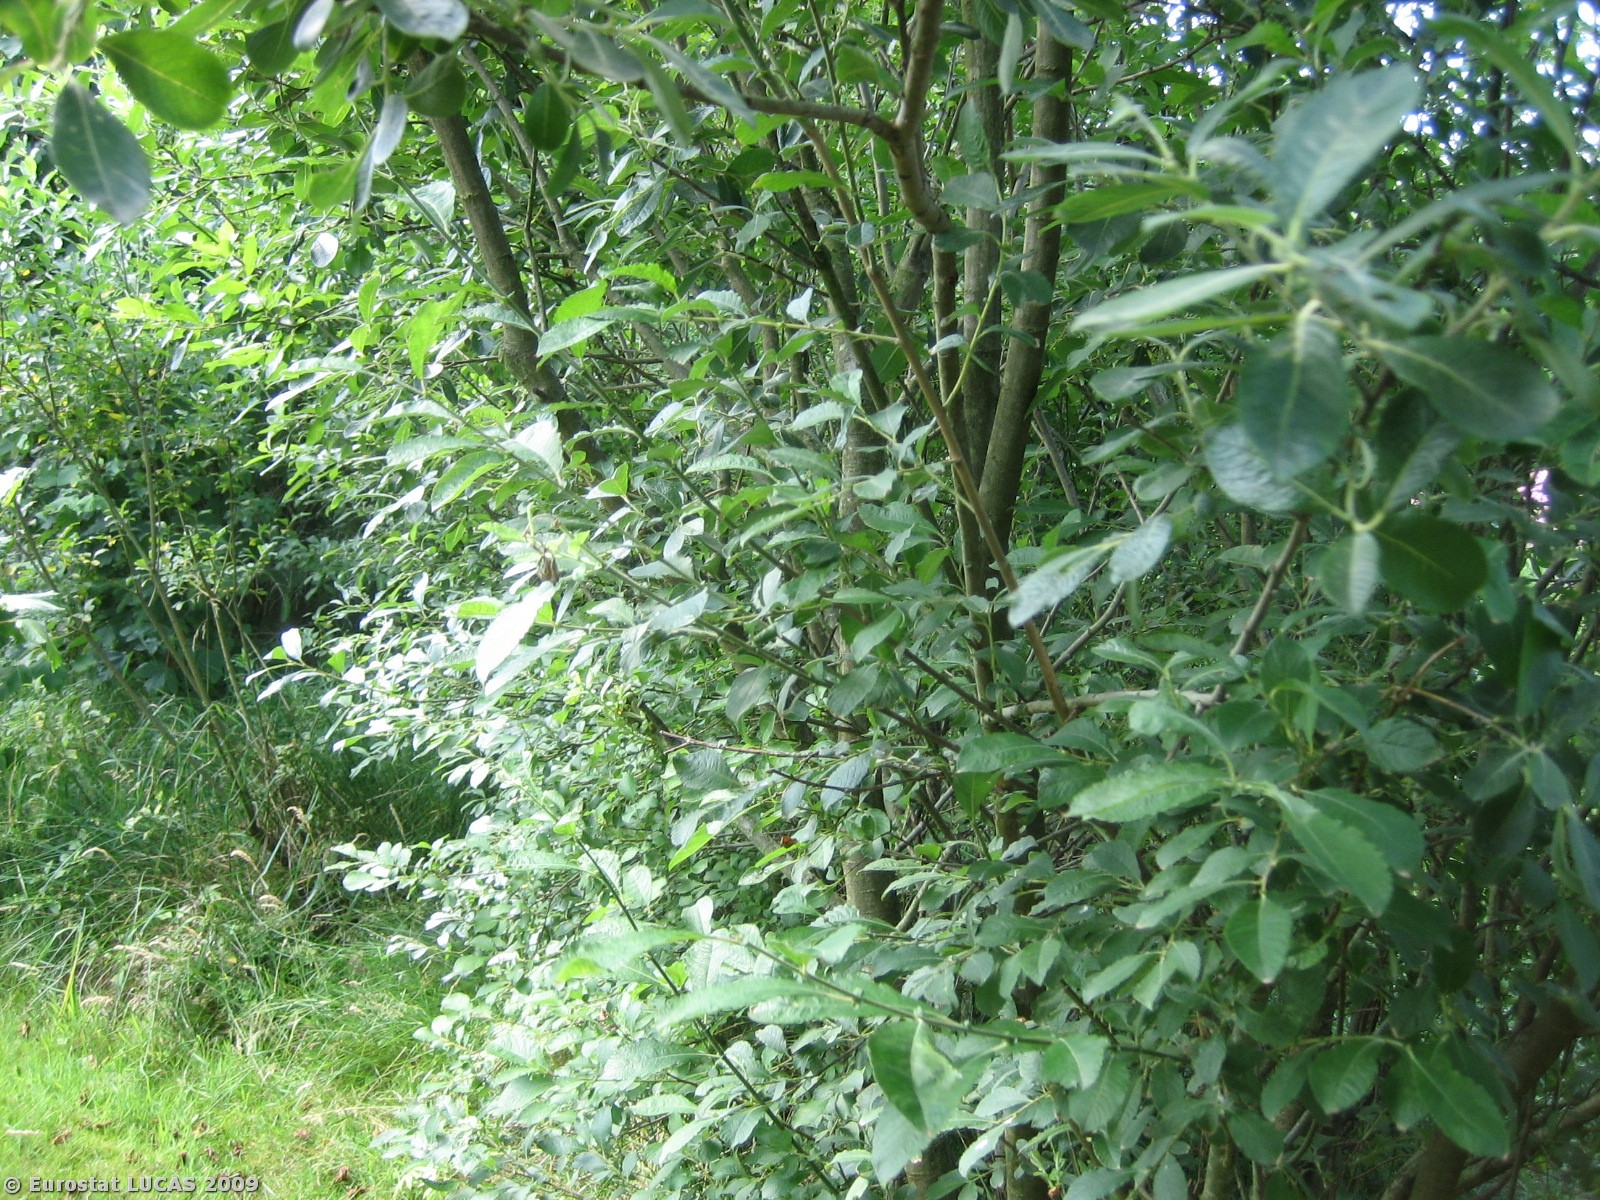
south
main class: Grassland
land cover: Grassland with sparse tree/shrub cover
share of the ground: > 75 %
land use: Residential
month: July
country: DK
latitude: 55.6971
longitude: 8.8397
